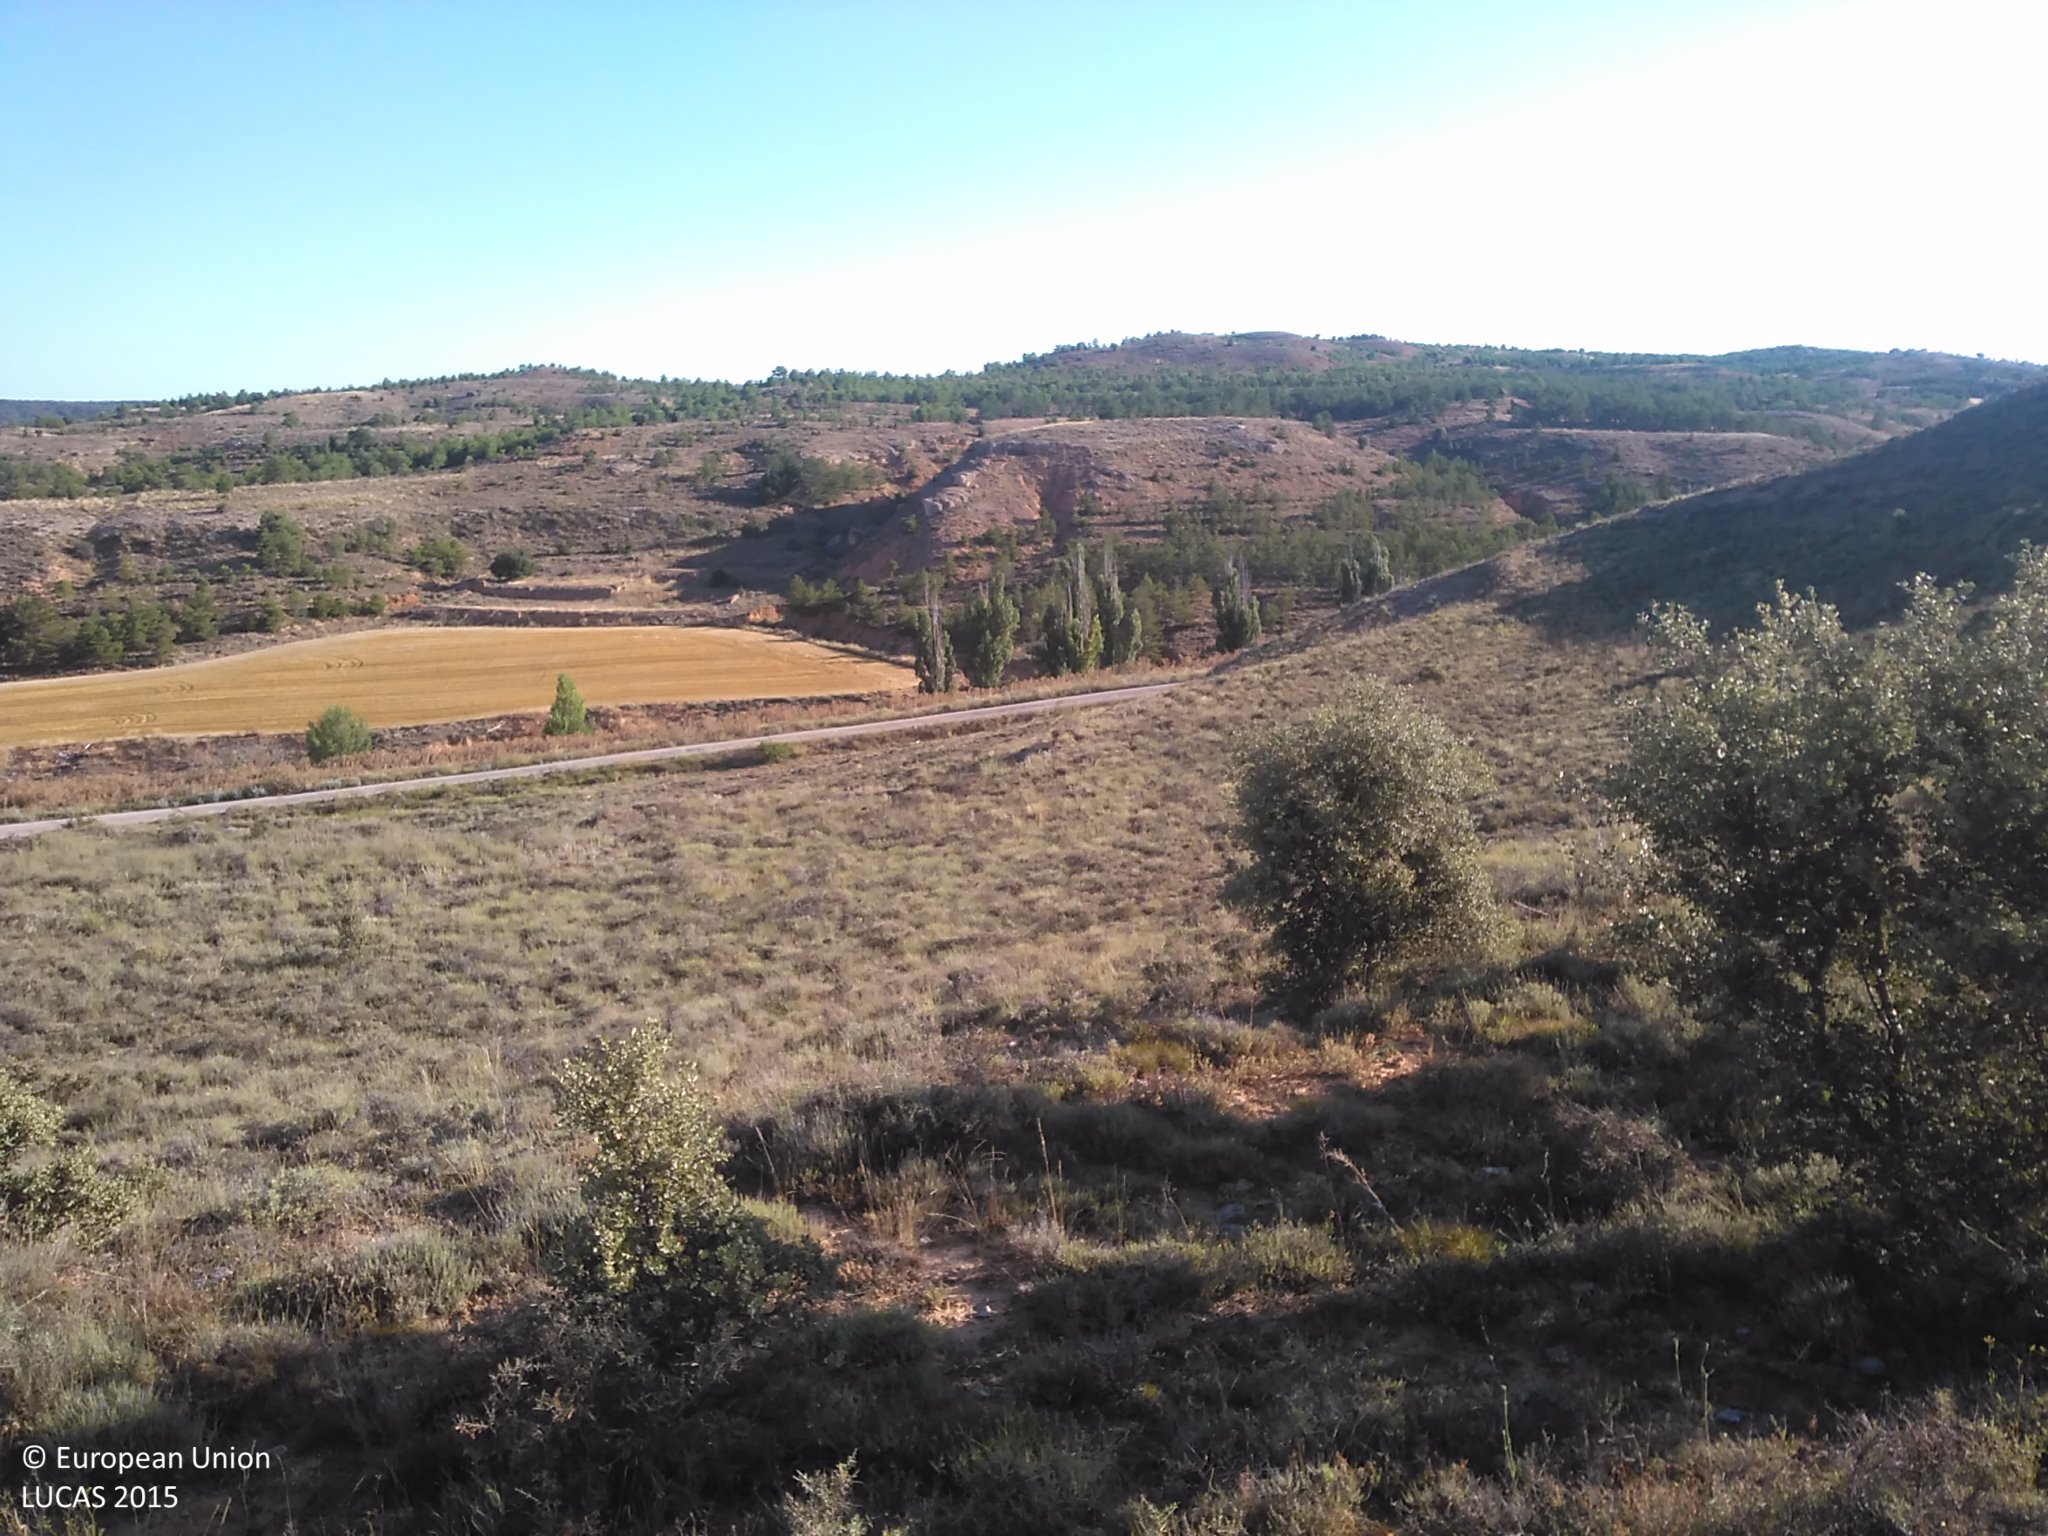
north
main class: Shrubland
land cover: Shrubland without tree cover
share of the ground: 50 - 75 %
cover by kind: shrubs 70 %, unconsolidated bare surface 30 %
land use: Semi-natural and natural areas not in use
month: July
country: ES
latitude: 41.4950
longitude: -2.1903
